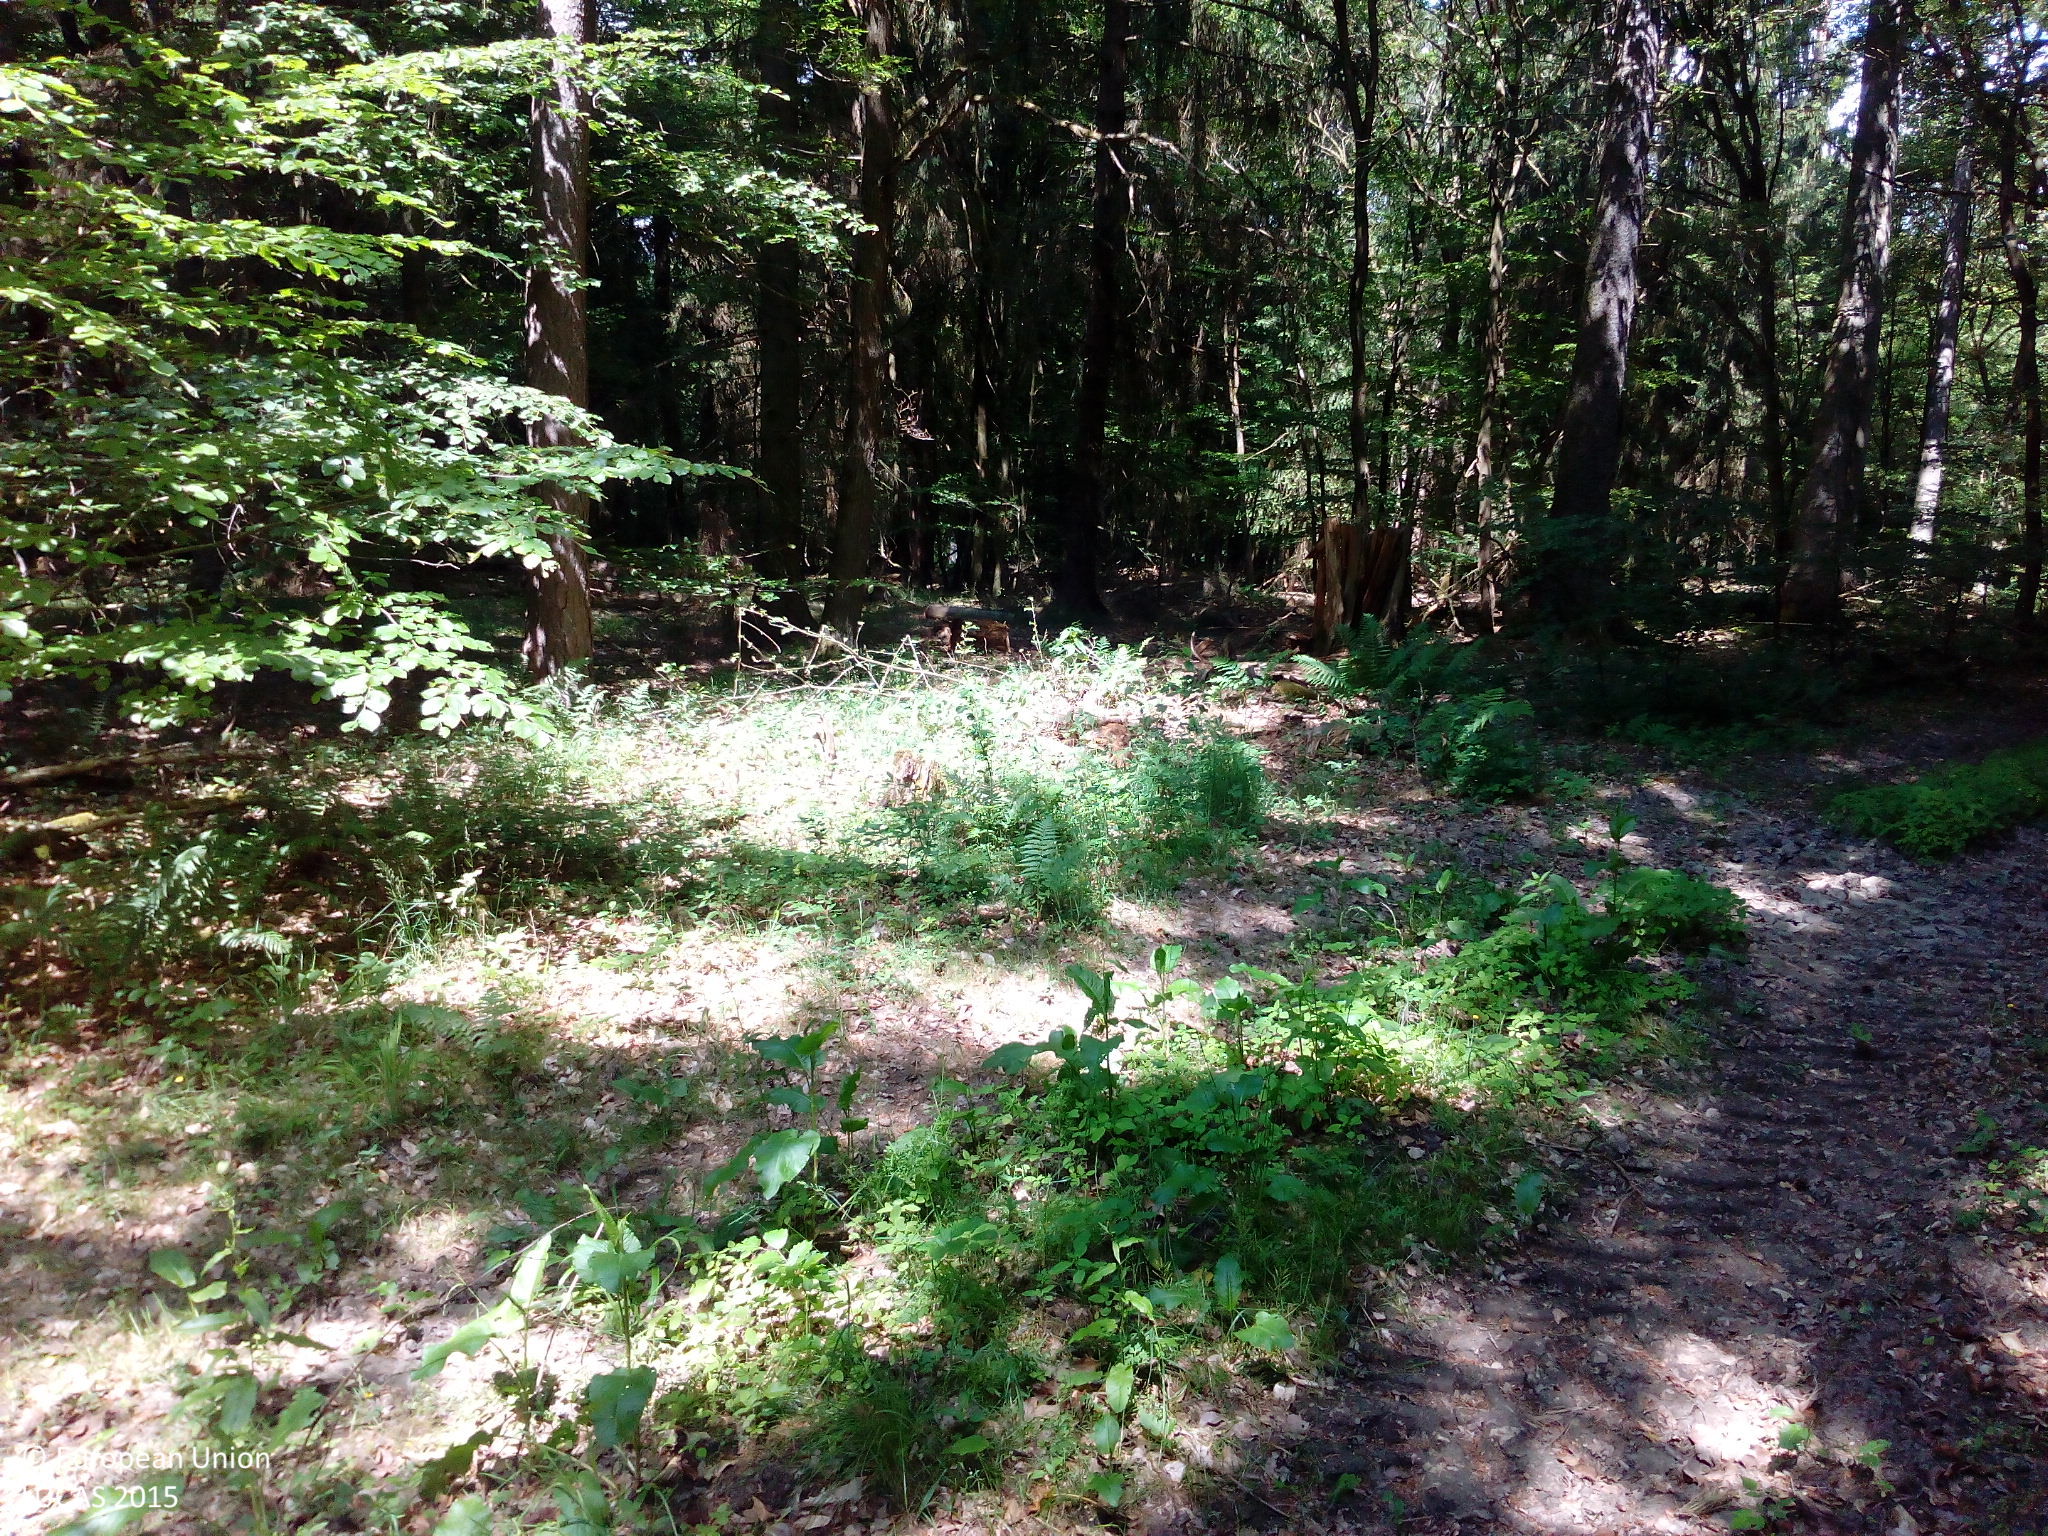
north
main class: Woodland
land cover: Other mixed woodland
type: mesophytic deciduous forest
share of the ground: > 75 %
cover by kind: broadleaved forest trees 60 %, coniferous forest trees 25 %, unconsolidated bare surface 10 %, lichens and mosses 5 %
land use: Forestry
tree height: > 5 m
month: June
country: DE
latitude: 50.3736
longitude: 8.6084
